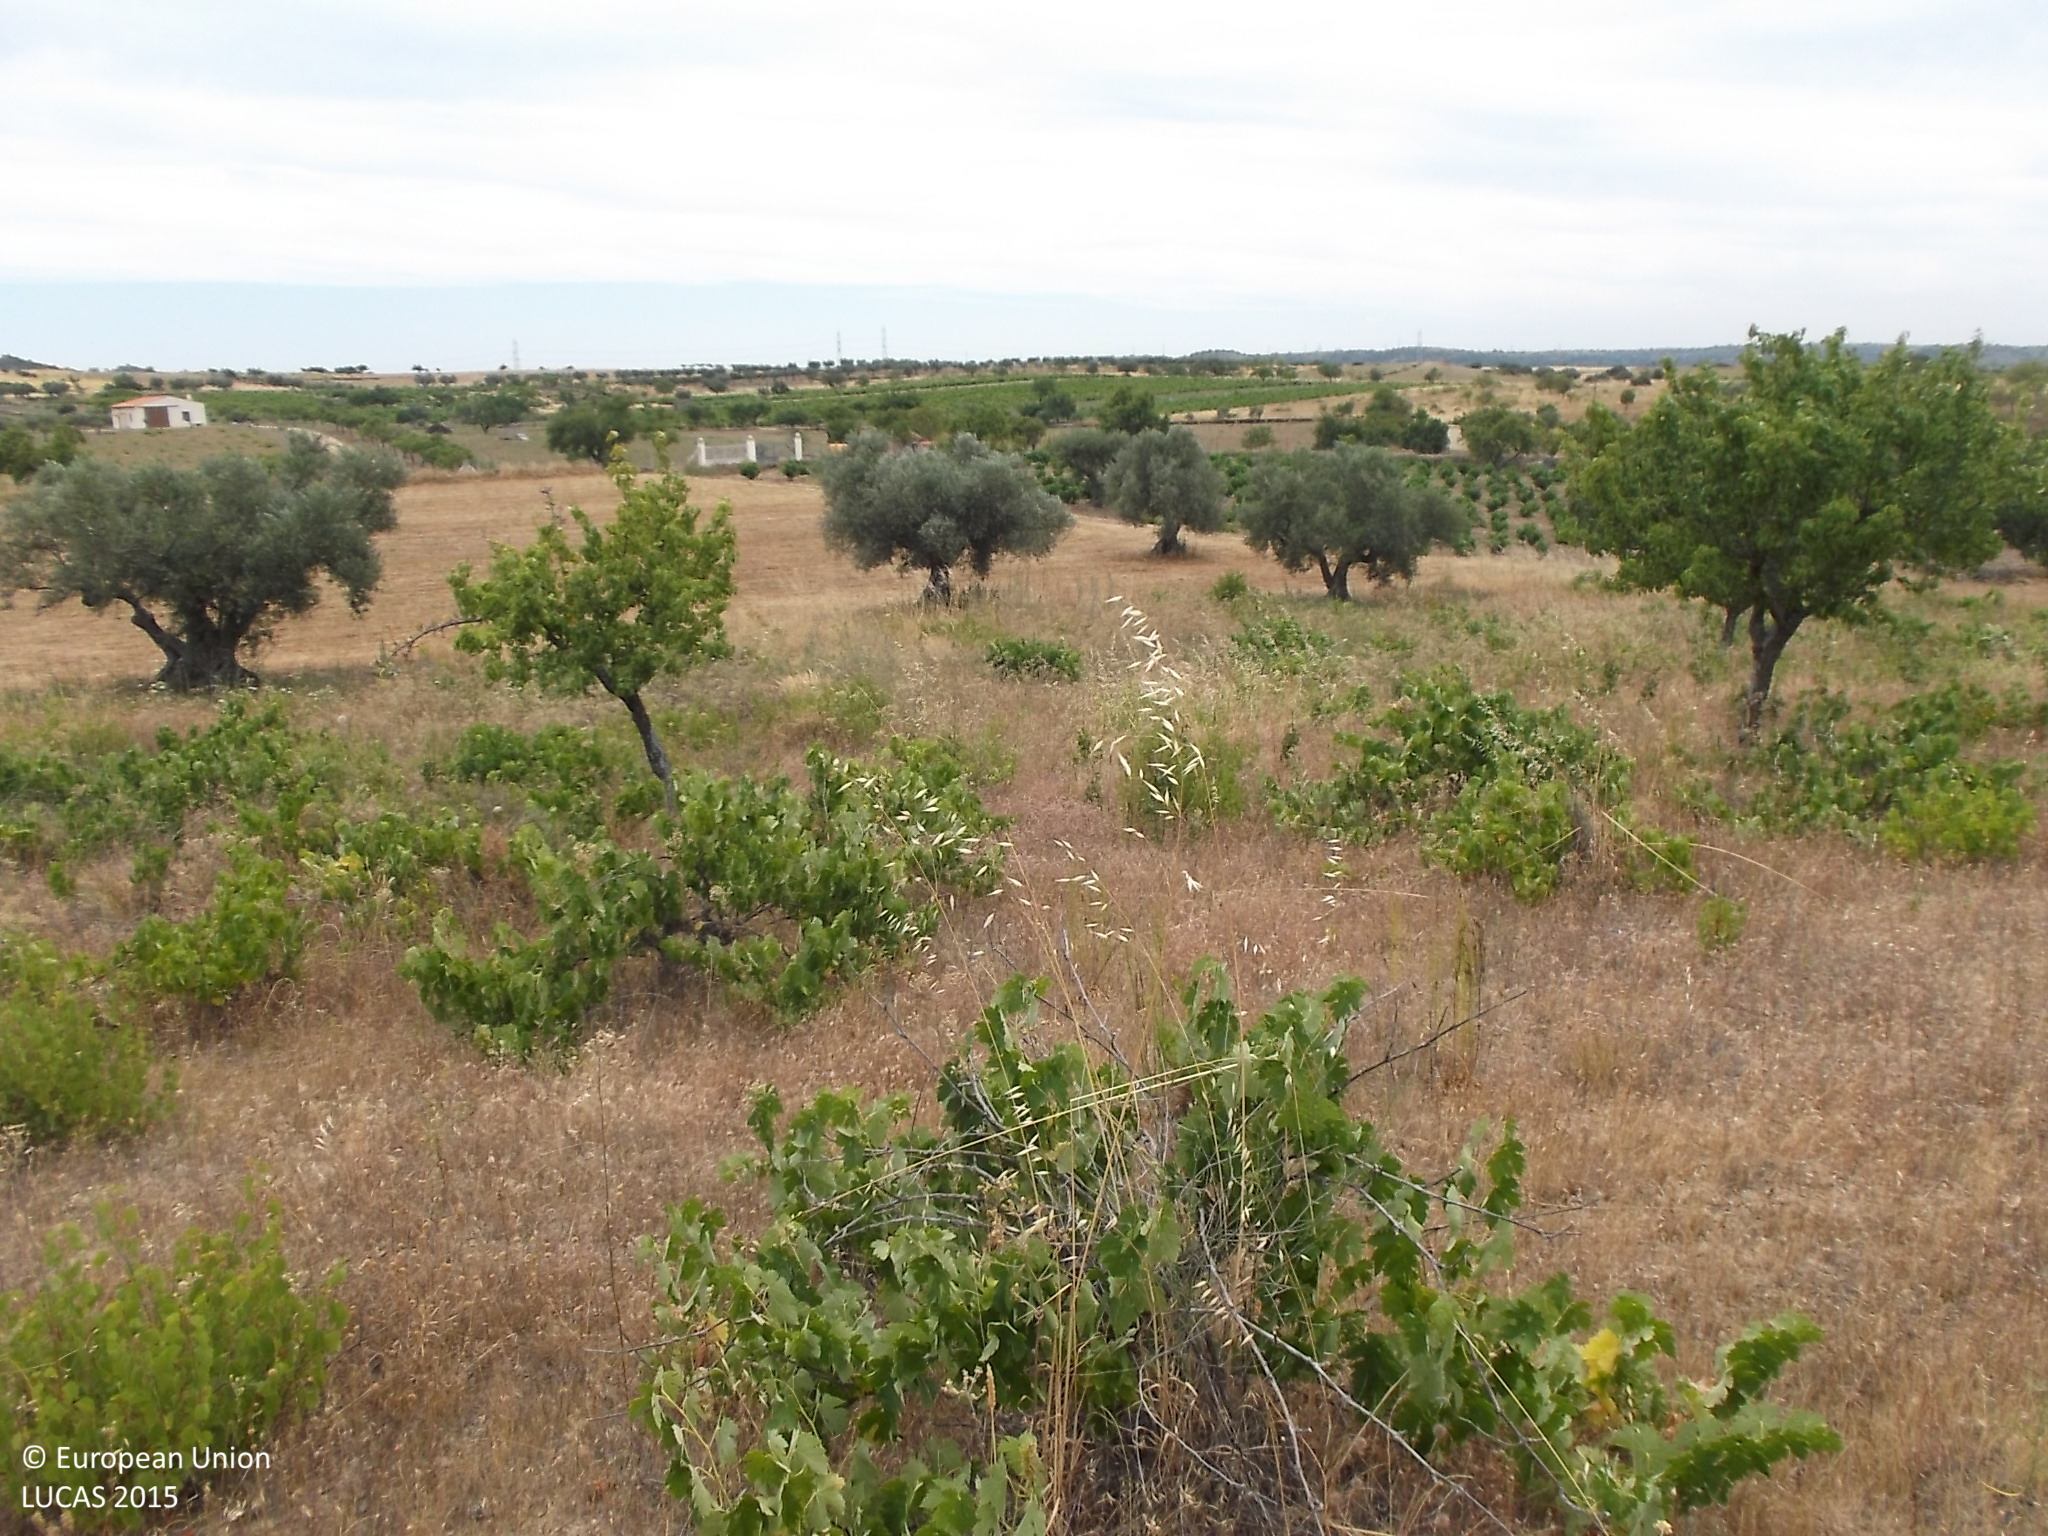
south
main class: Cropland
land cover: Vineyards
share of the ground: 10 - 25 %
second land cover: Spontaneously vegetated surfaces
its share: > 75 %
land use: Agriculture (excluding fallow land and kitchen gardens)
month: July
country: ES
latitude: 41.3064
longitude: -6.4012
